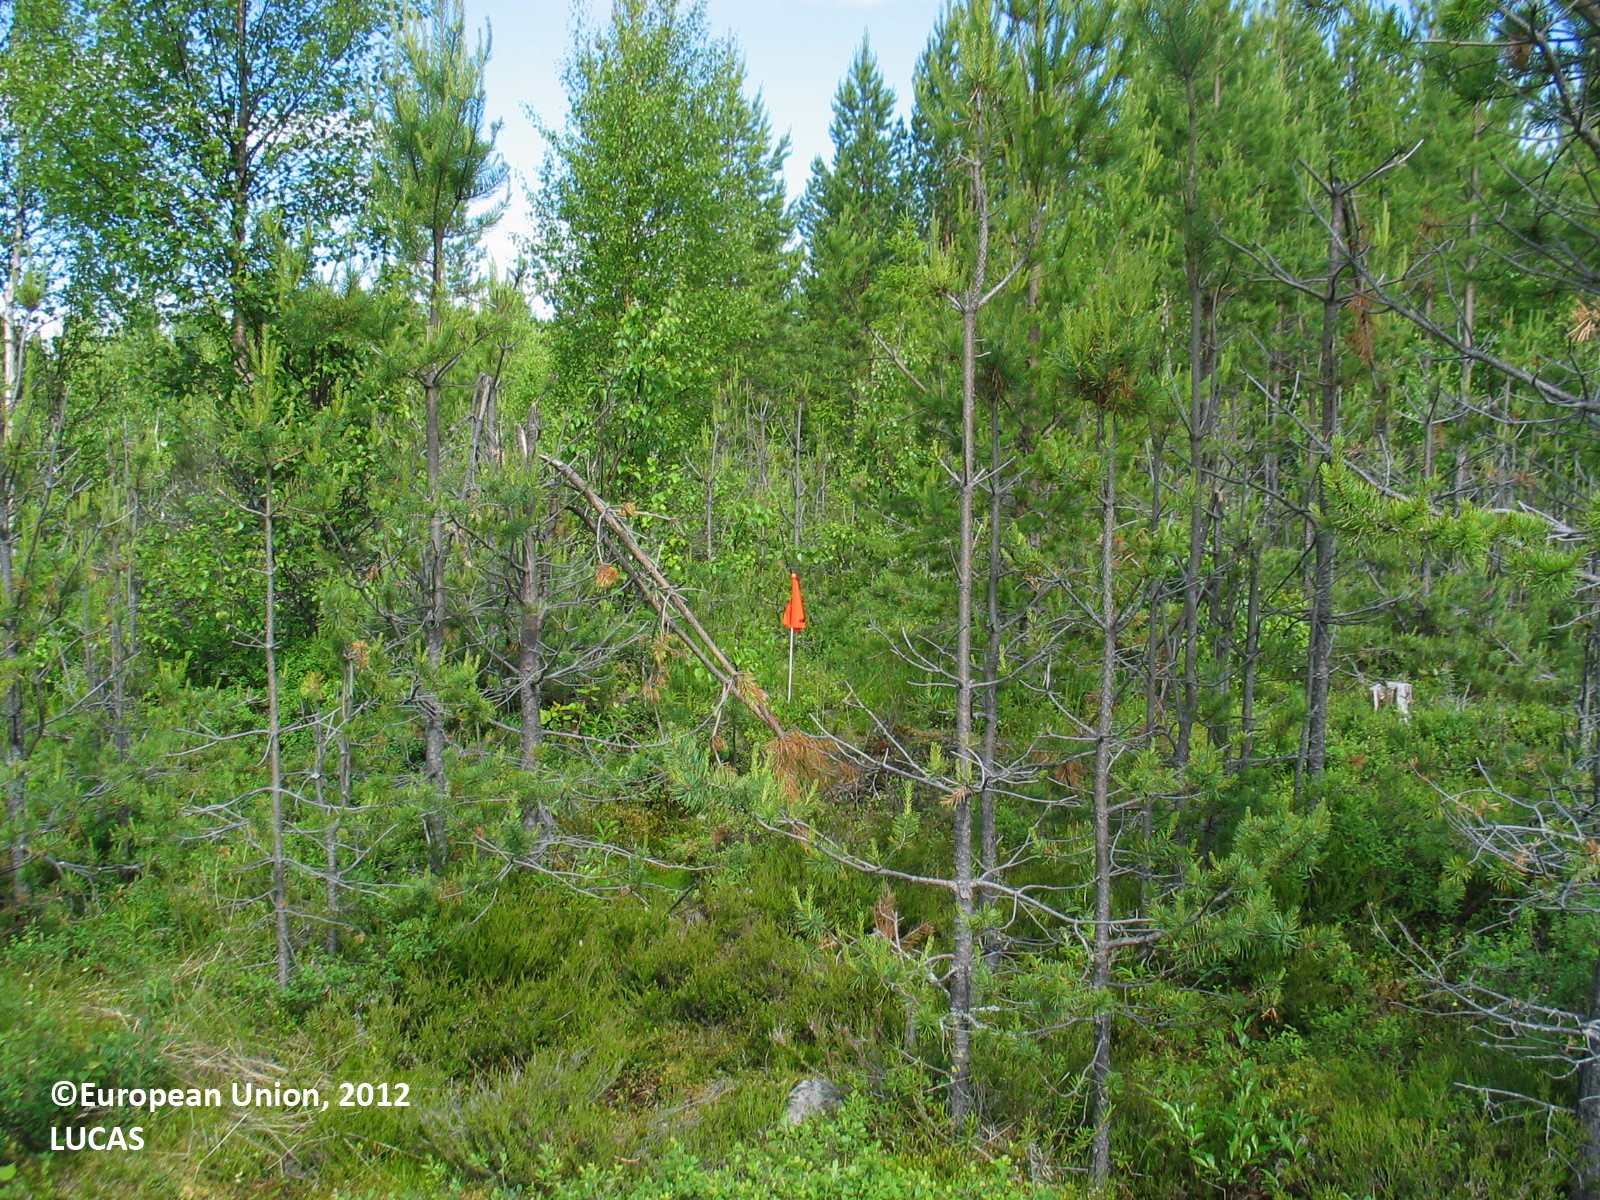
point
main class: Woodland
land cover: Other mixed woodland
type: boreal forest
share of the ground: 25 - 50 %
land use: Forestry
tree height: < 5 m
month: July
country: FI
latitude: 64.7563
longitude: 26.6114
